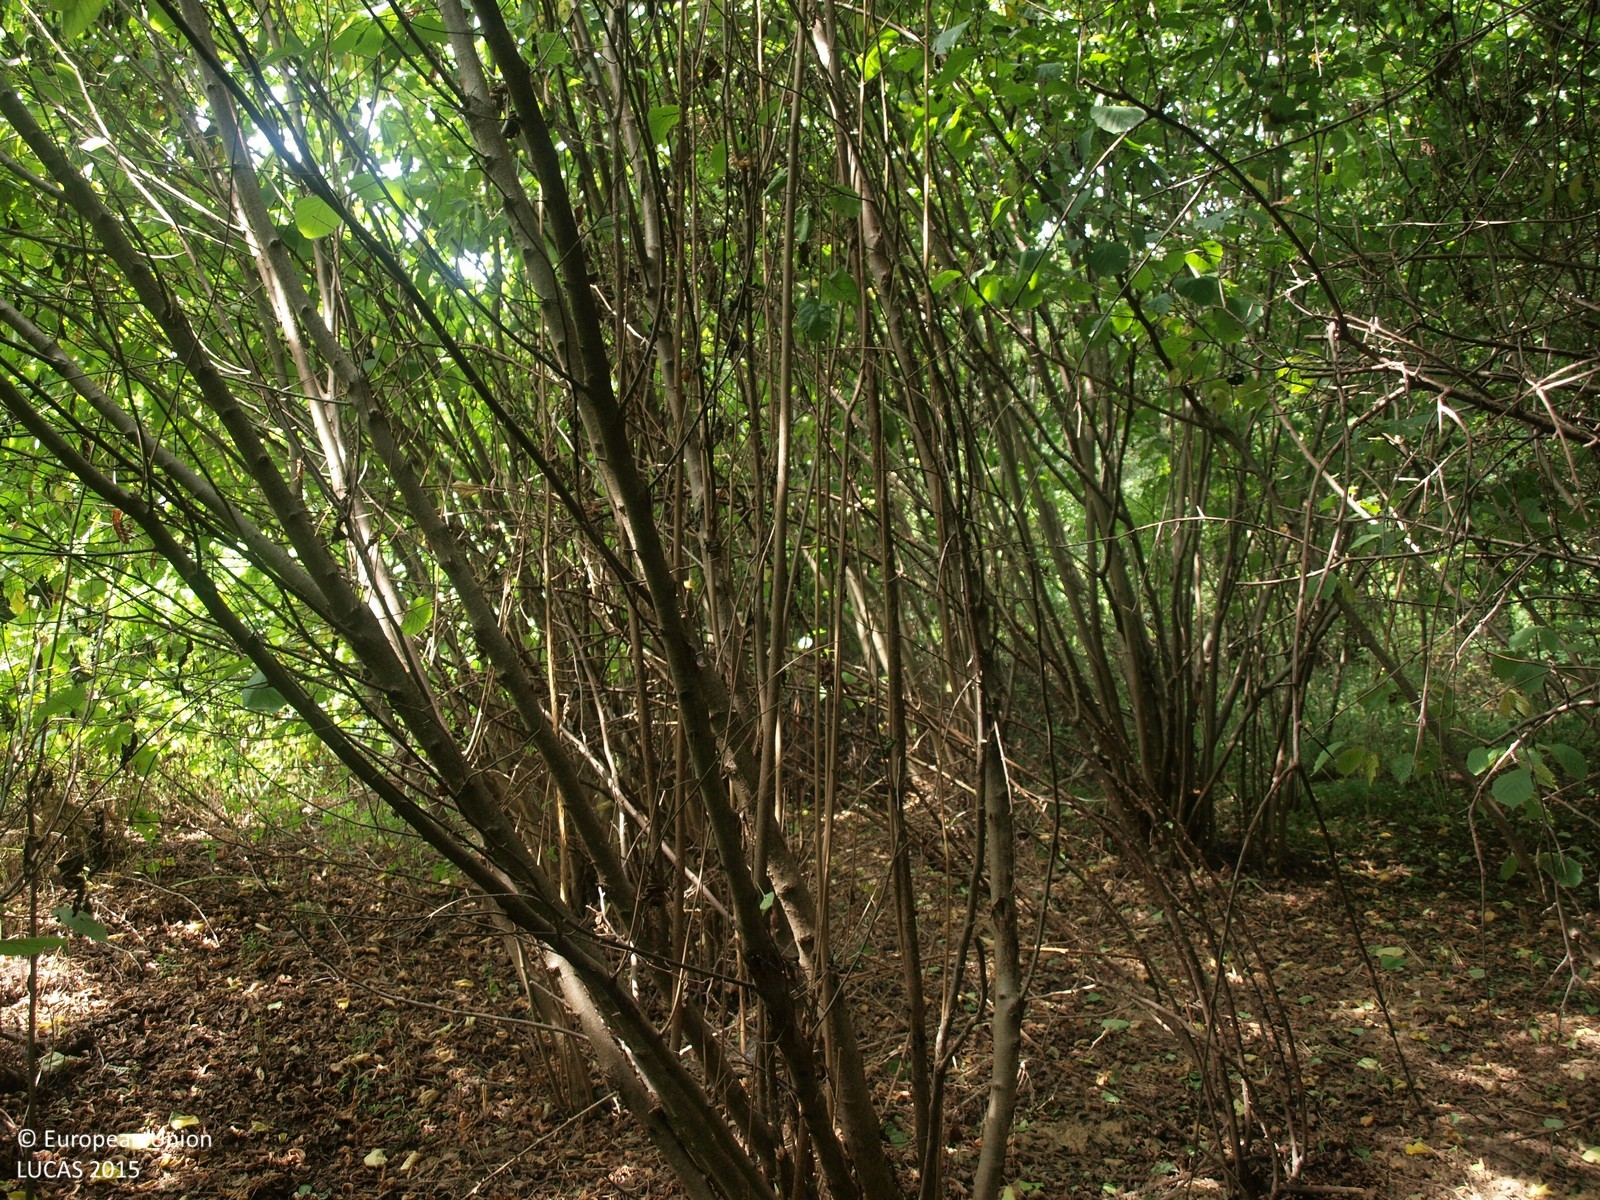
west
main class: Shrubland
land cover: Shrubland with sparse tree cover
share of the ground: > 75 %
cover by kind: shrubs 95 %, broadleaved forest trees 5 %
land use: Forestry
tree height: < 5 m
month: August
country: HR
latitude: 46.0887
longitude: 16.3757
